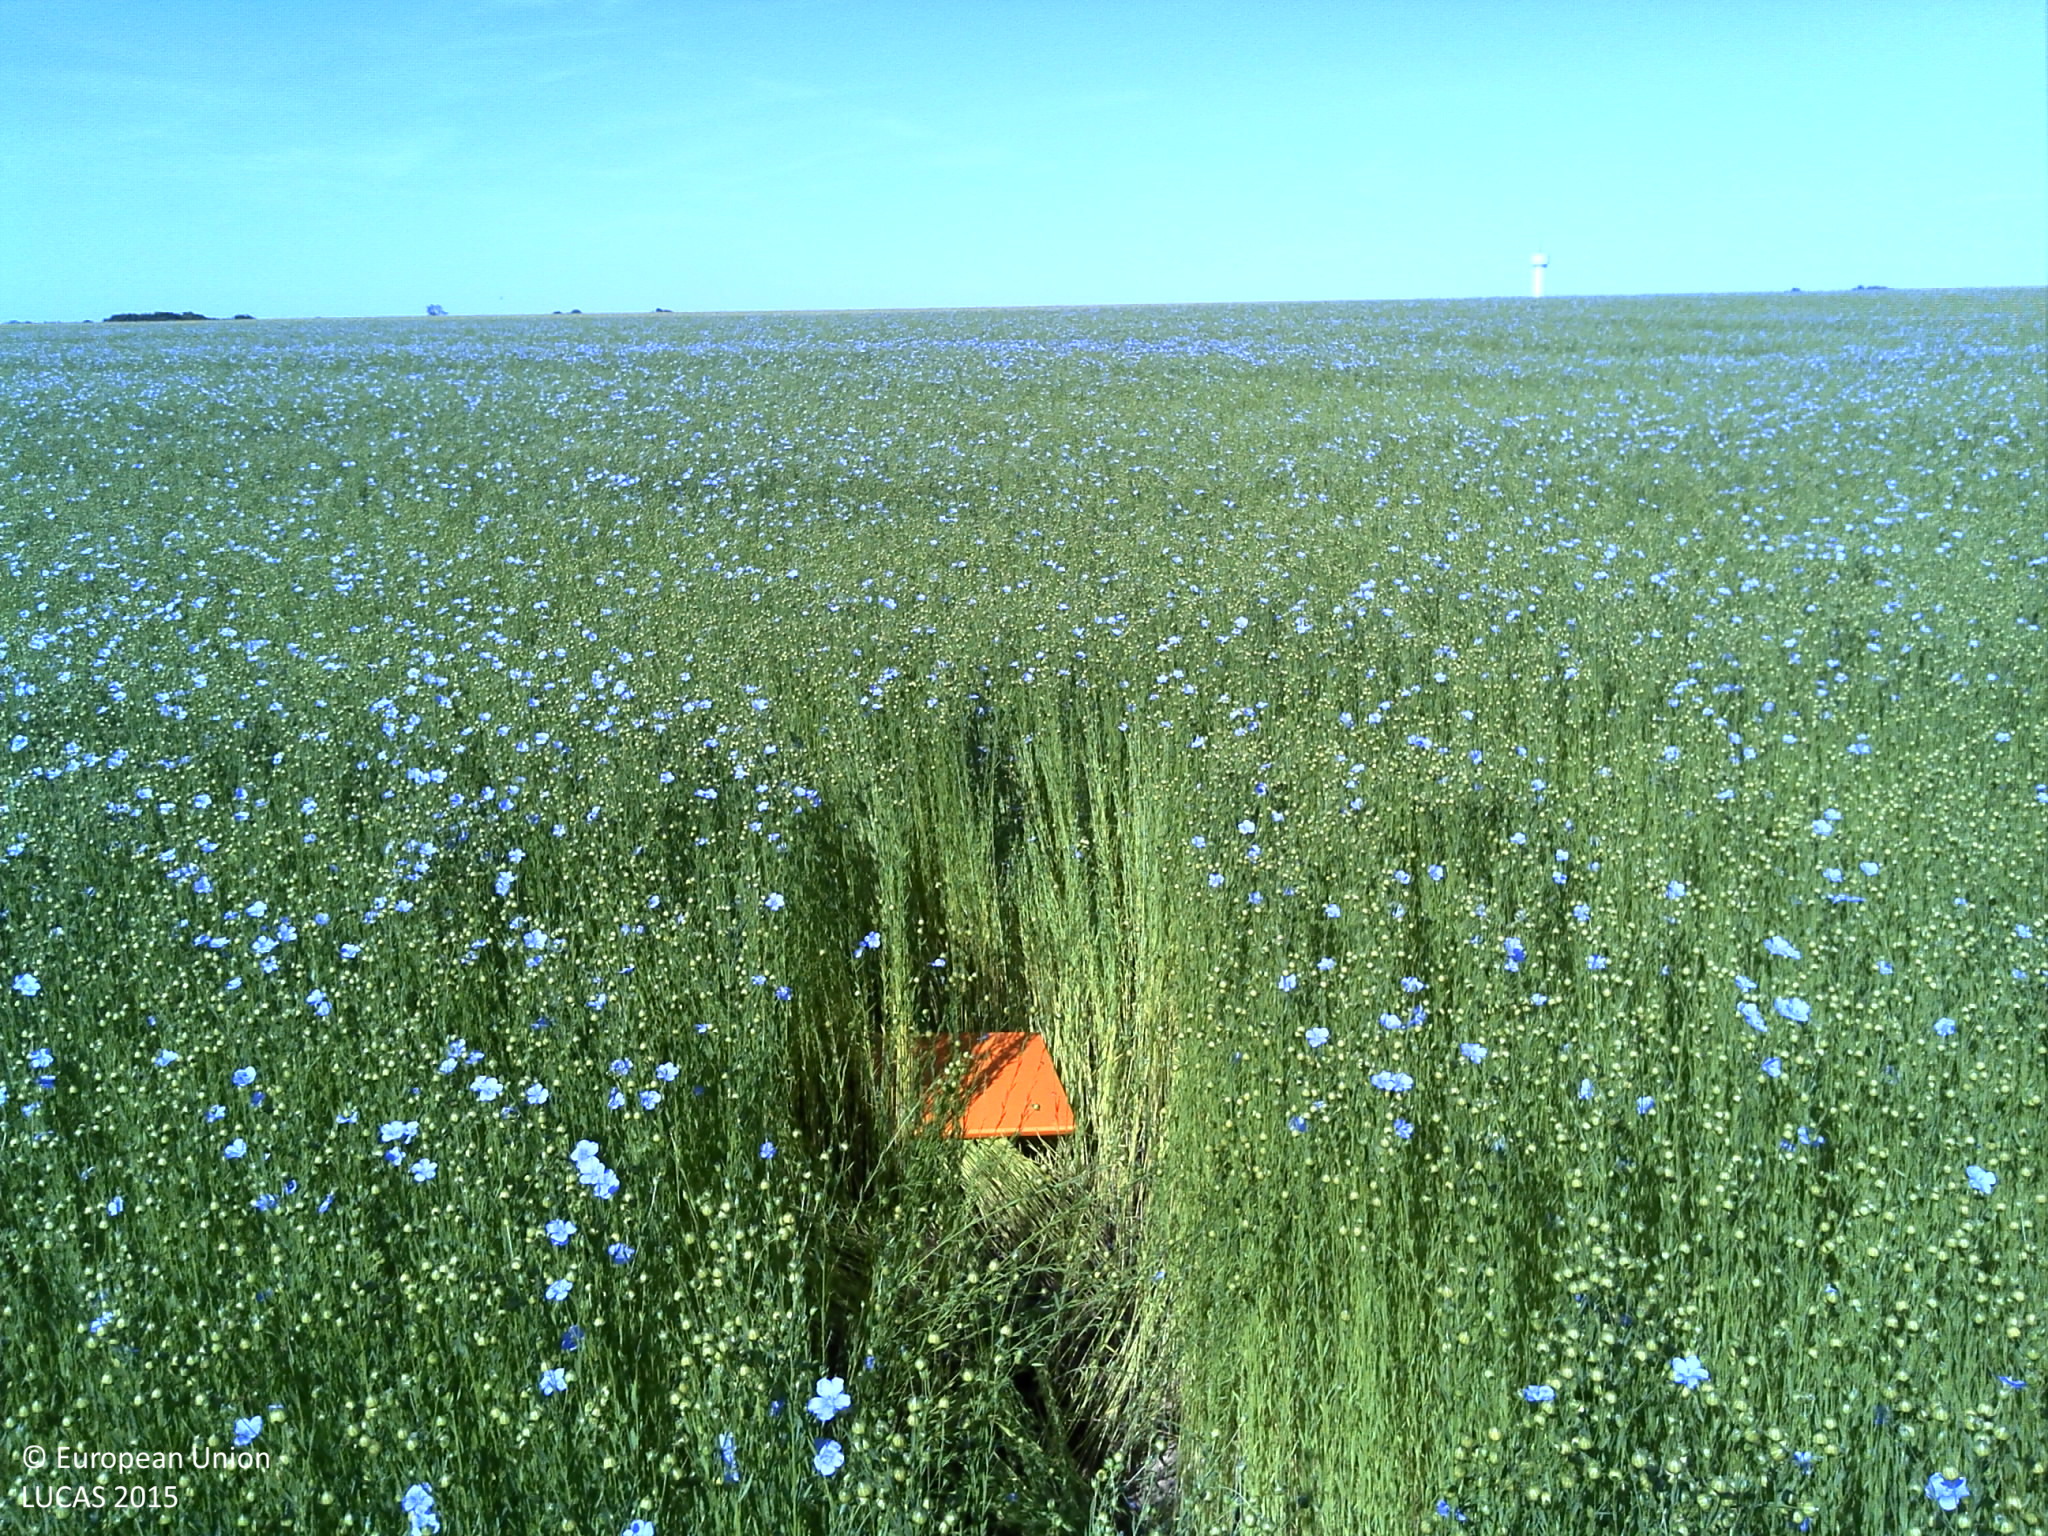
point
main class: Cropland
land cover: Other fibre and oleaginous crops
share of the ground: > 75 %
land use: Agriculture (excluding fallow land and kitchen gardens)
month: June
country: FR
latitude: 49.8041
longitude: 0.9314
